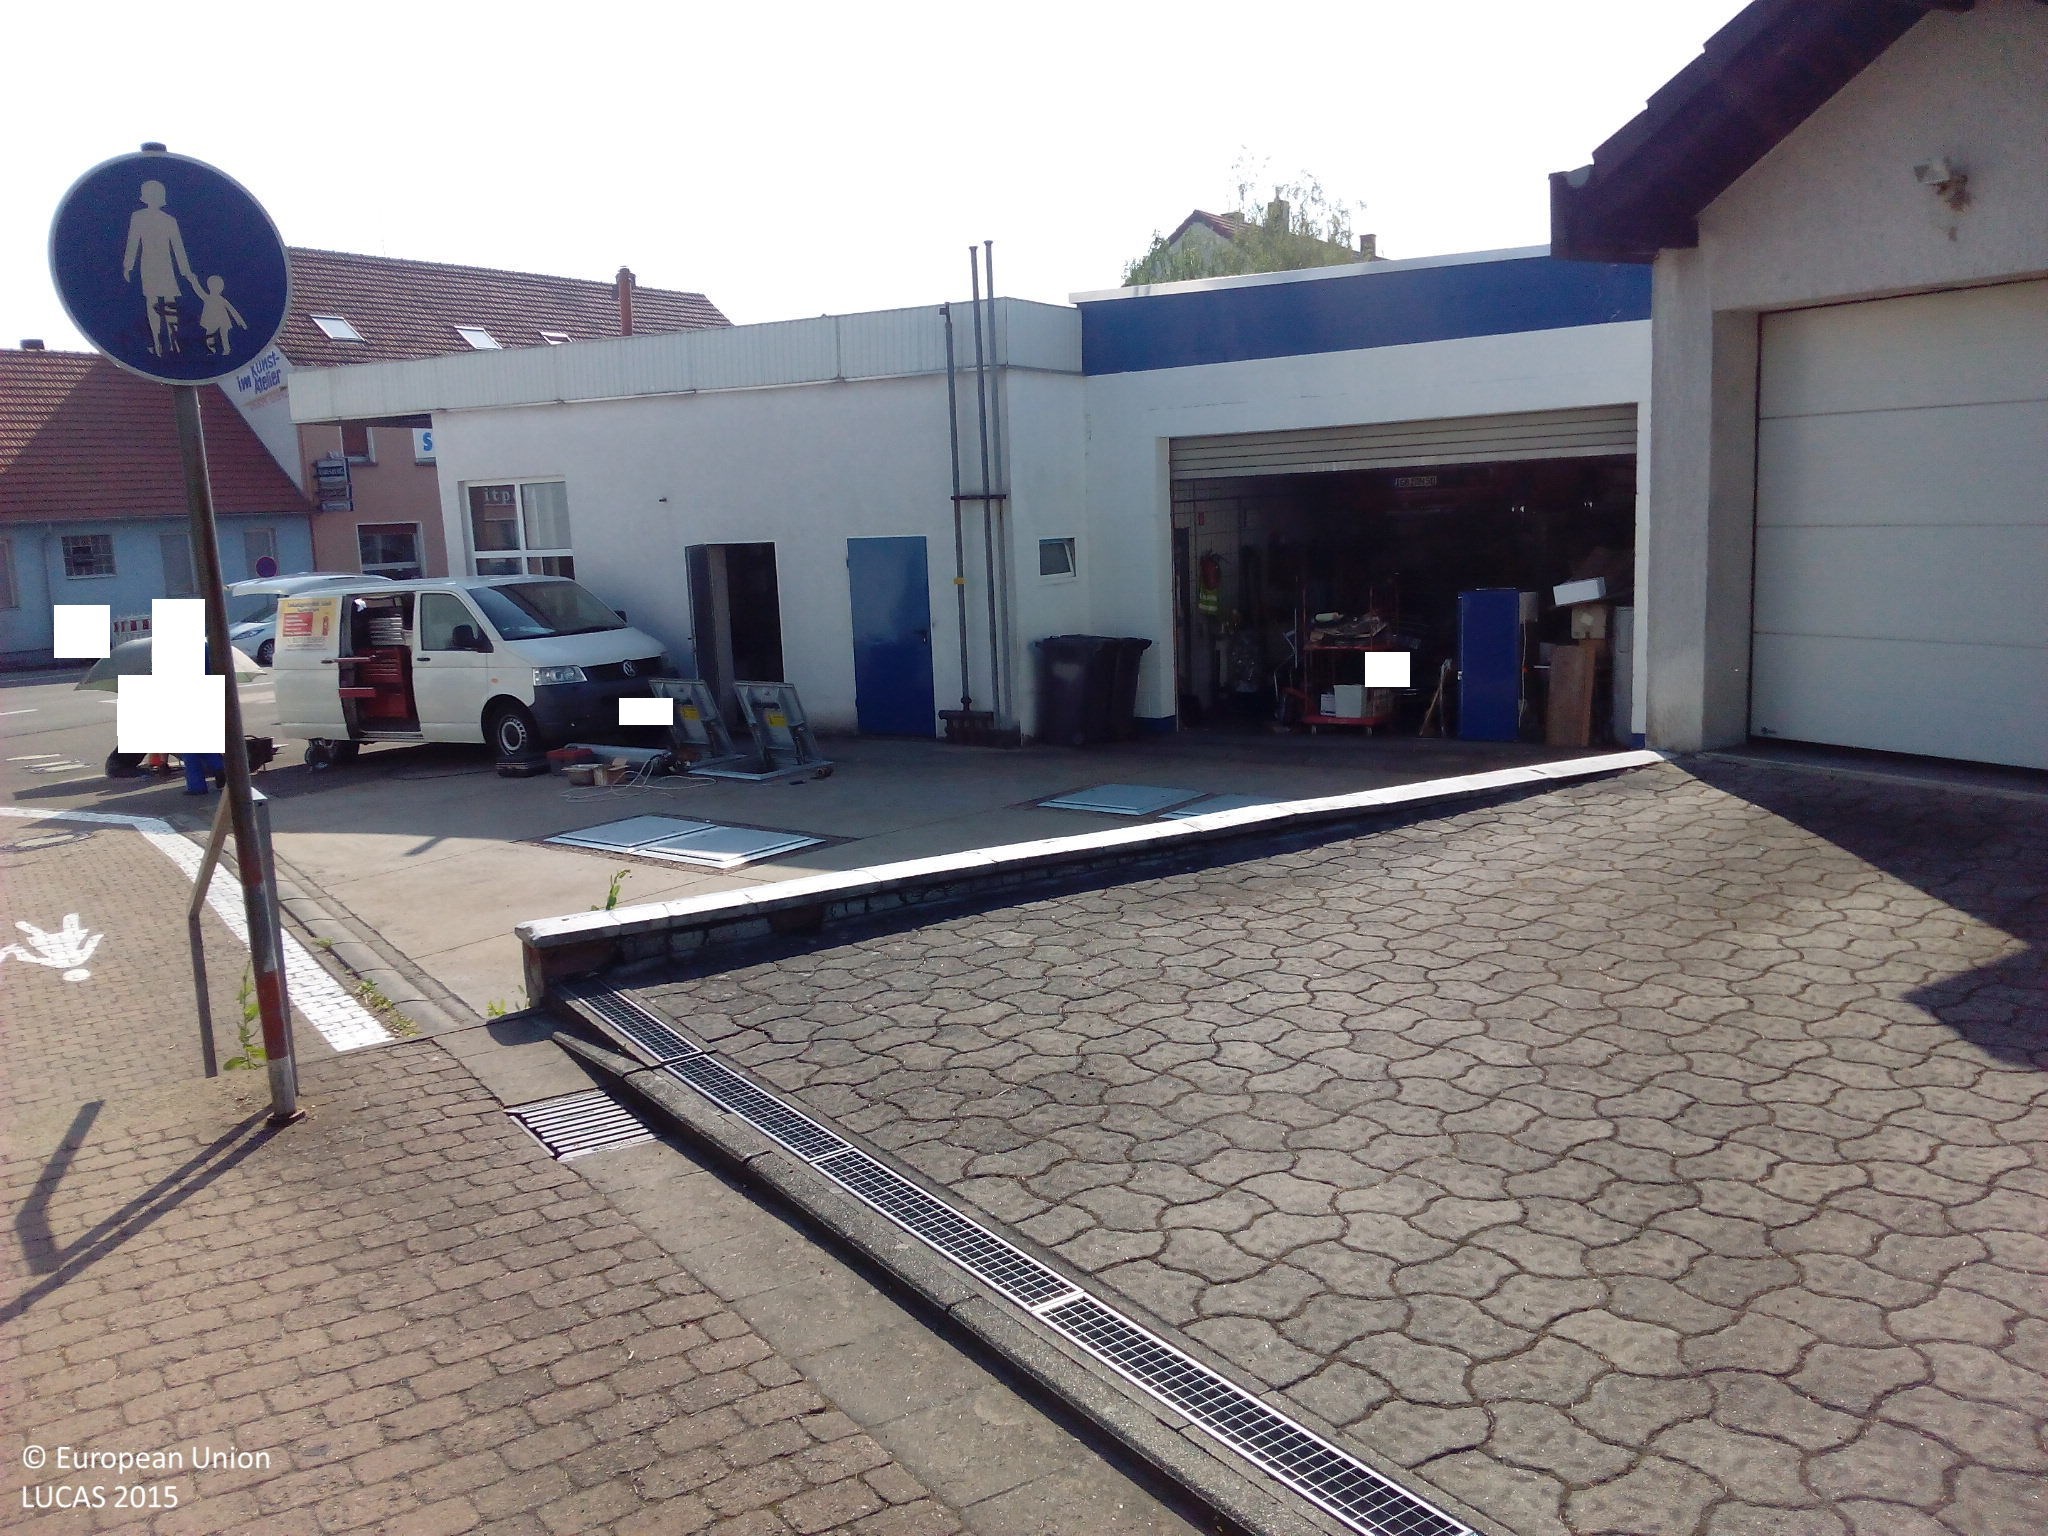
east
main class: Cropland
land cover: Cherry fruit
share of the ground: 25 - 50 %
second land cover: Grassland without tree/shrub cover
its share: > 75 %
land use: Kitchen garden
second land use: Residential
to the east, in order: Conifer hedges; Artificial constructions in urban areas
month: July
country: DE
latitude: 49.2850
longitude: 7.1546
